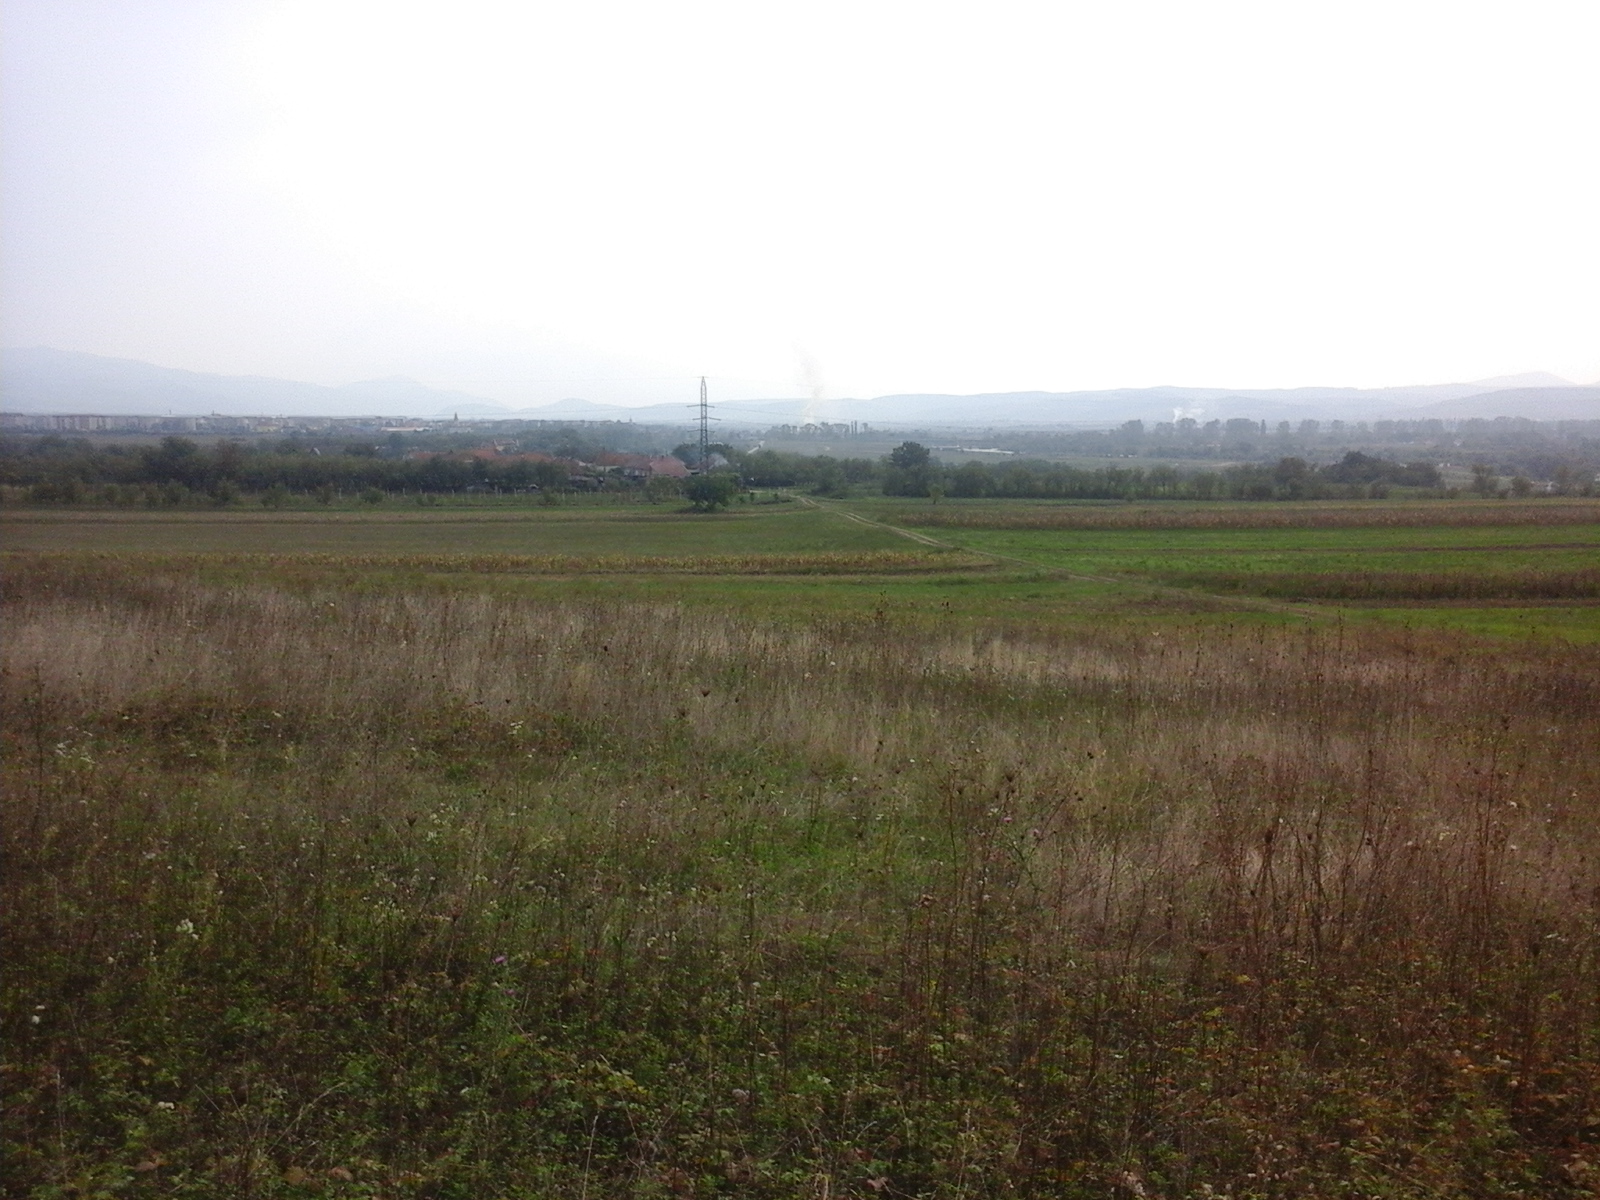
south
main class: Grassland
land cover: Spontaneously vegetated surfaces
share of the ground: > 75 %
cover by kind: herbaceous plants 100 %
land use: Agriculture (excluding fallow land and kitchen gardens)
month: September
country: RO
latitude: 45.7513
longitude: 23.0256
